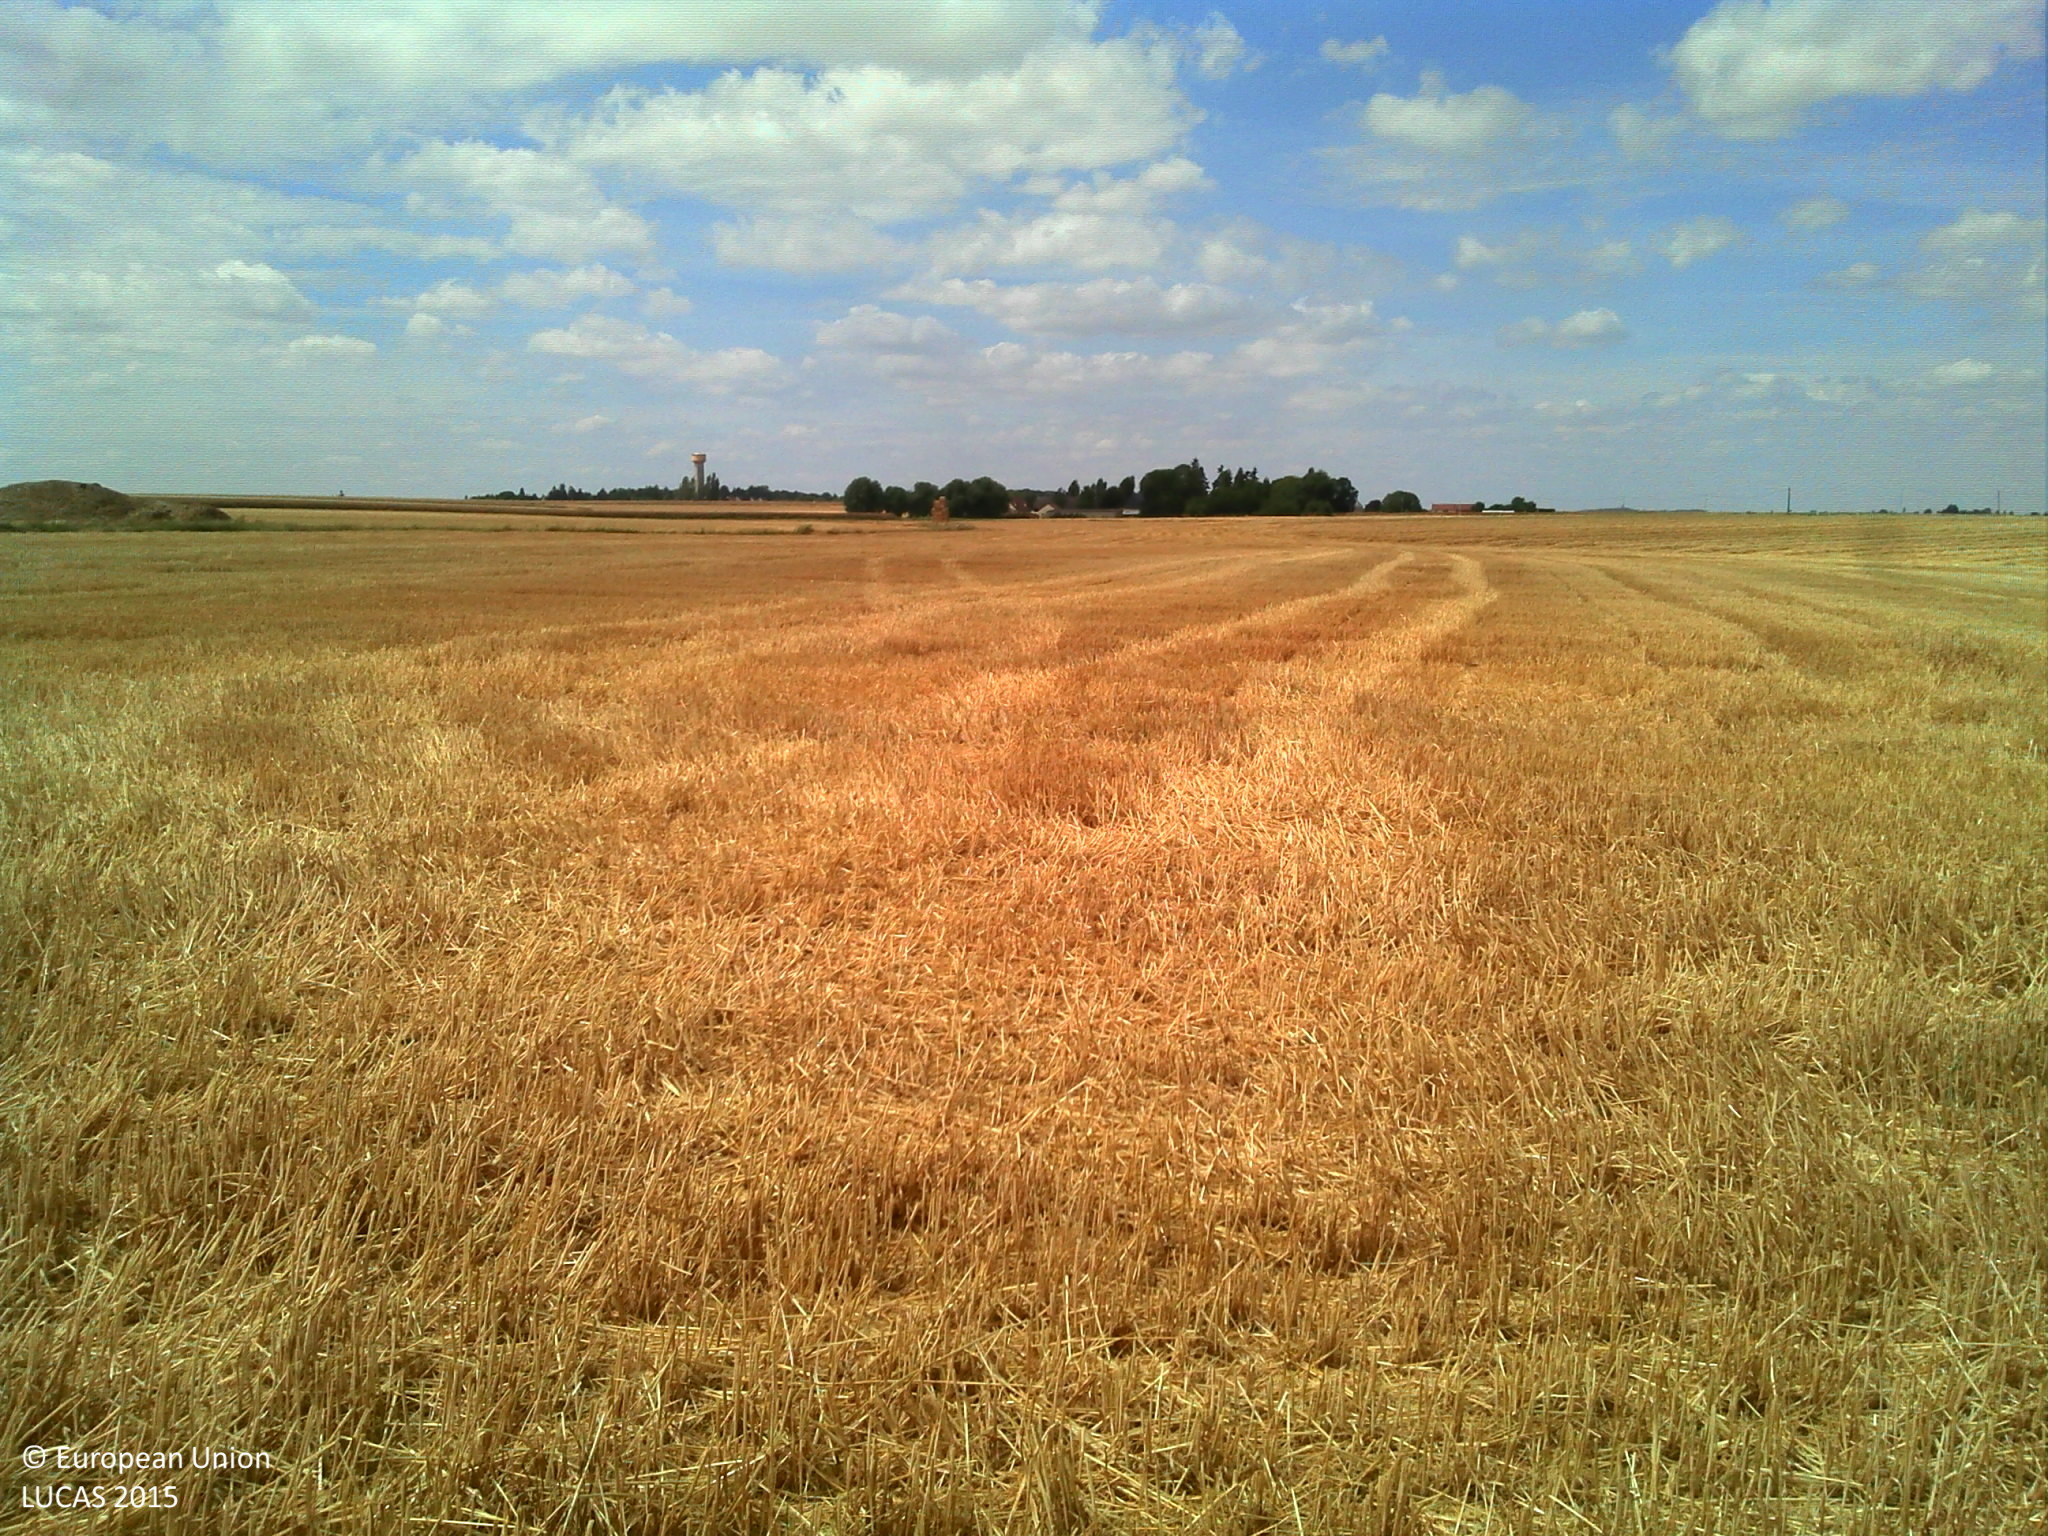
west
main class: Cropland
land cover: Rape and turnip rape
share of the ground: > 75 %
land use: Agriculture (excluding fallow land and kitchen gardens)
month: July
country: FR
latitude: 48.4707
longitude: 1.2300
